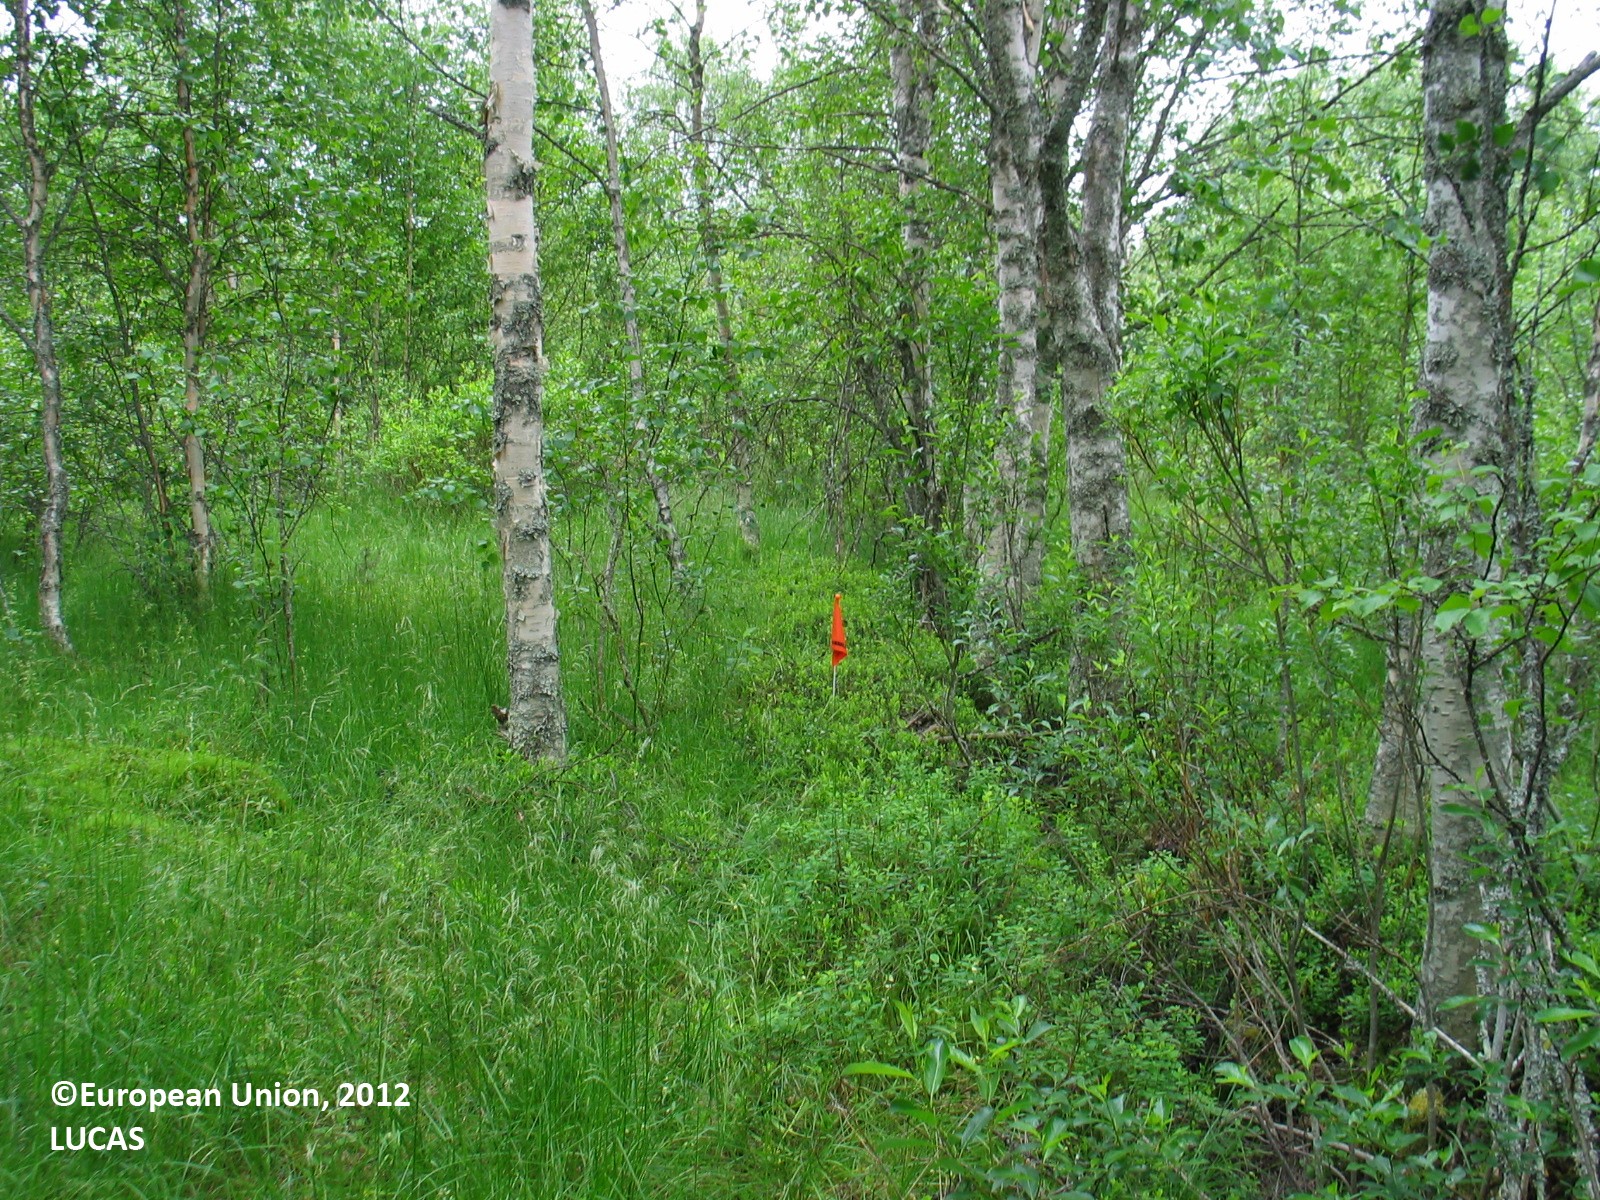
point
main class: Woodland
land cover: Broadleaved woodland
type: non-riverine alder, birch or aspen forest
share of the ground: 50 - 75 %
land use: Forestry
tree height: > 5 m
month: July
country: FI
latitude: 64.5954
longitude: 26.7281
